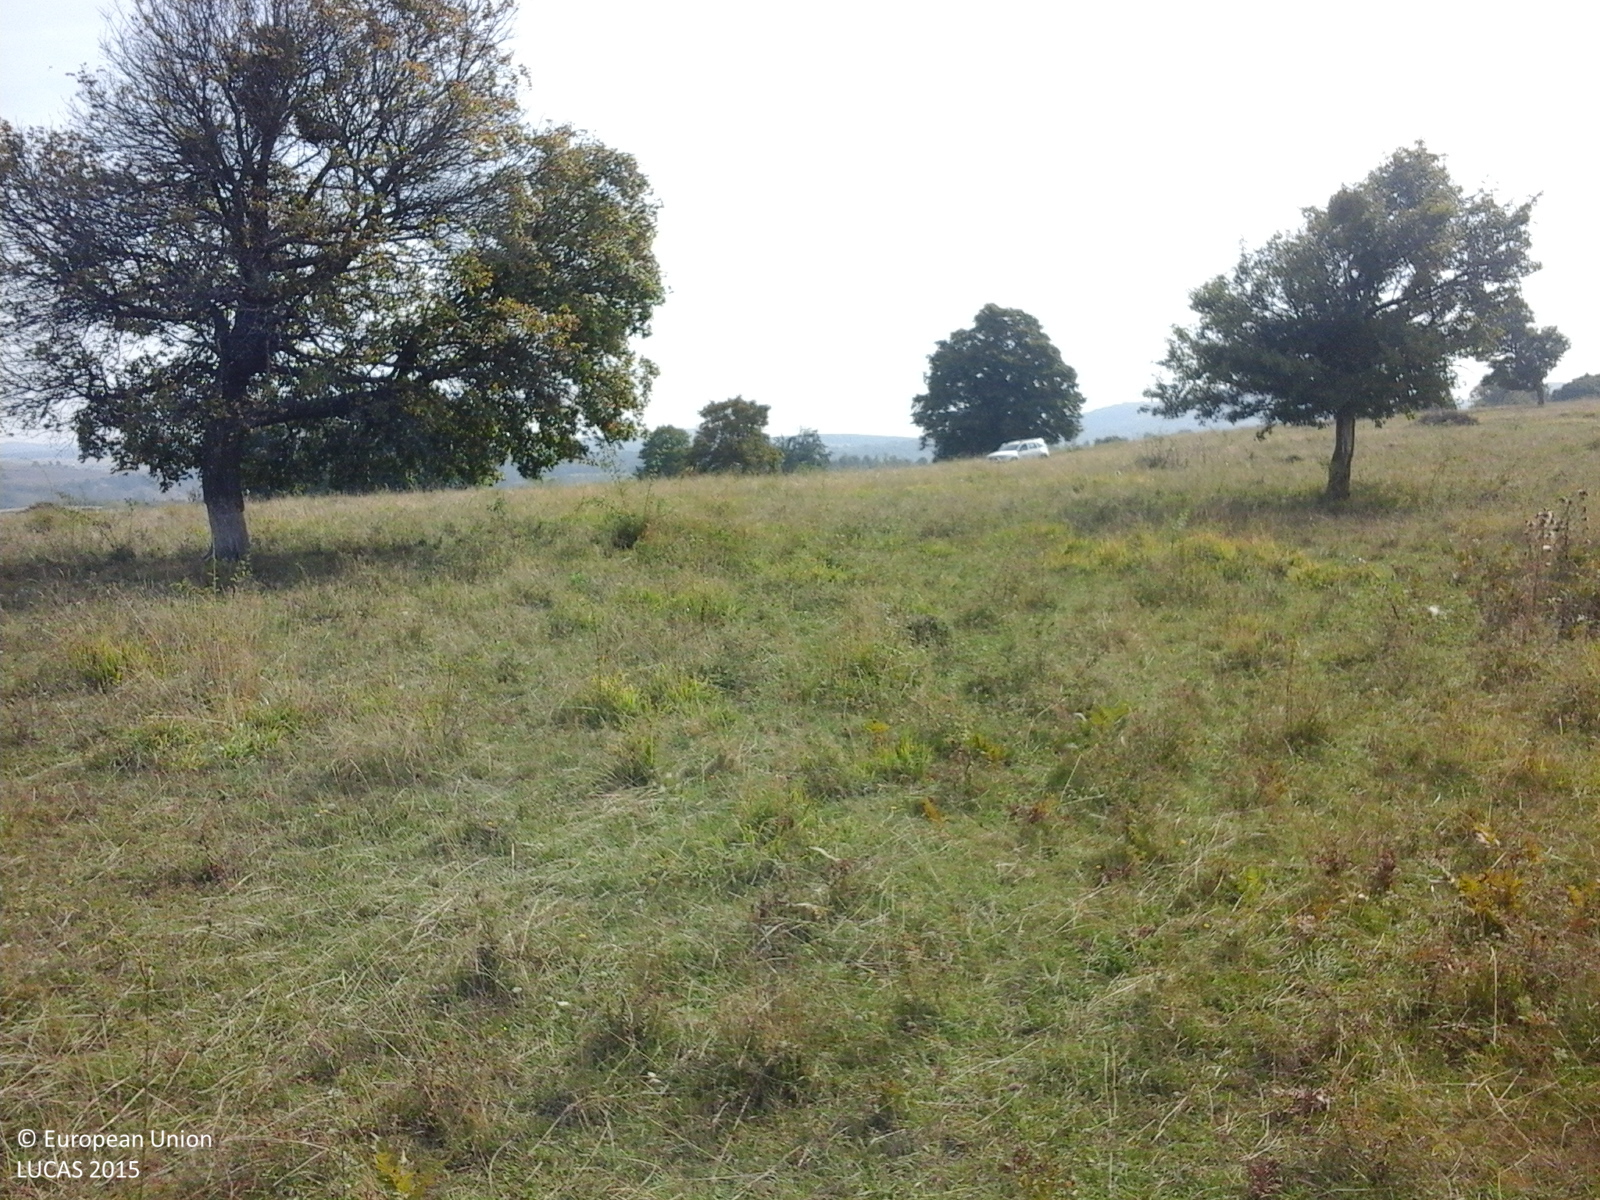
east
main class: Grassland
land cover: Grassland with sparse tree/shrub cover
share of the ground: > 75 %
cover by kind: herbaceous plants 85 %, shrubs 10 %, broadleaved forest trees 5 %
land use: Fallow land
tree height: < 5 m
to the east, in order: Grassland with sparse tree/shrub cover; Tracks; Grassland with sparse tree/shrub cover; Grassland without tree/shrub cover
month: September
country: RO
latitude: 46.8736
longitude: 23.0914
